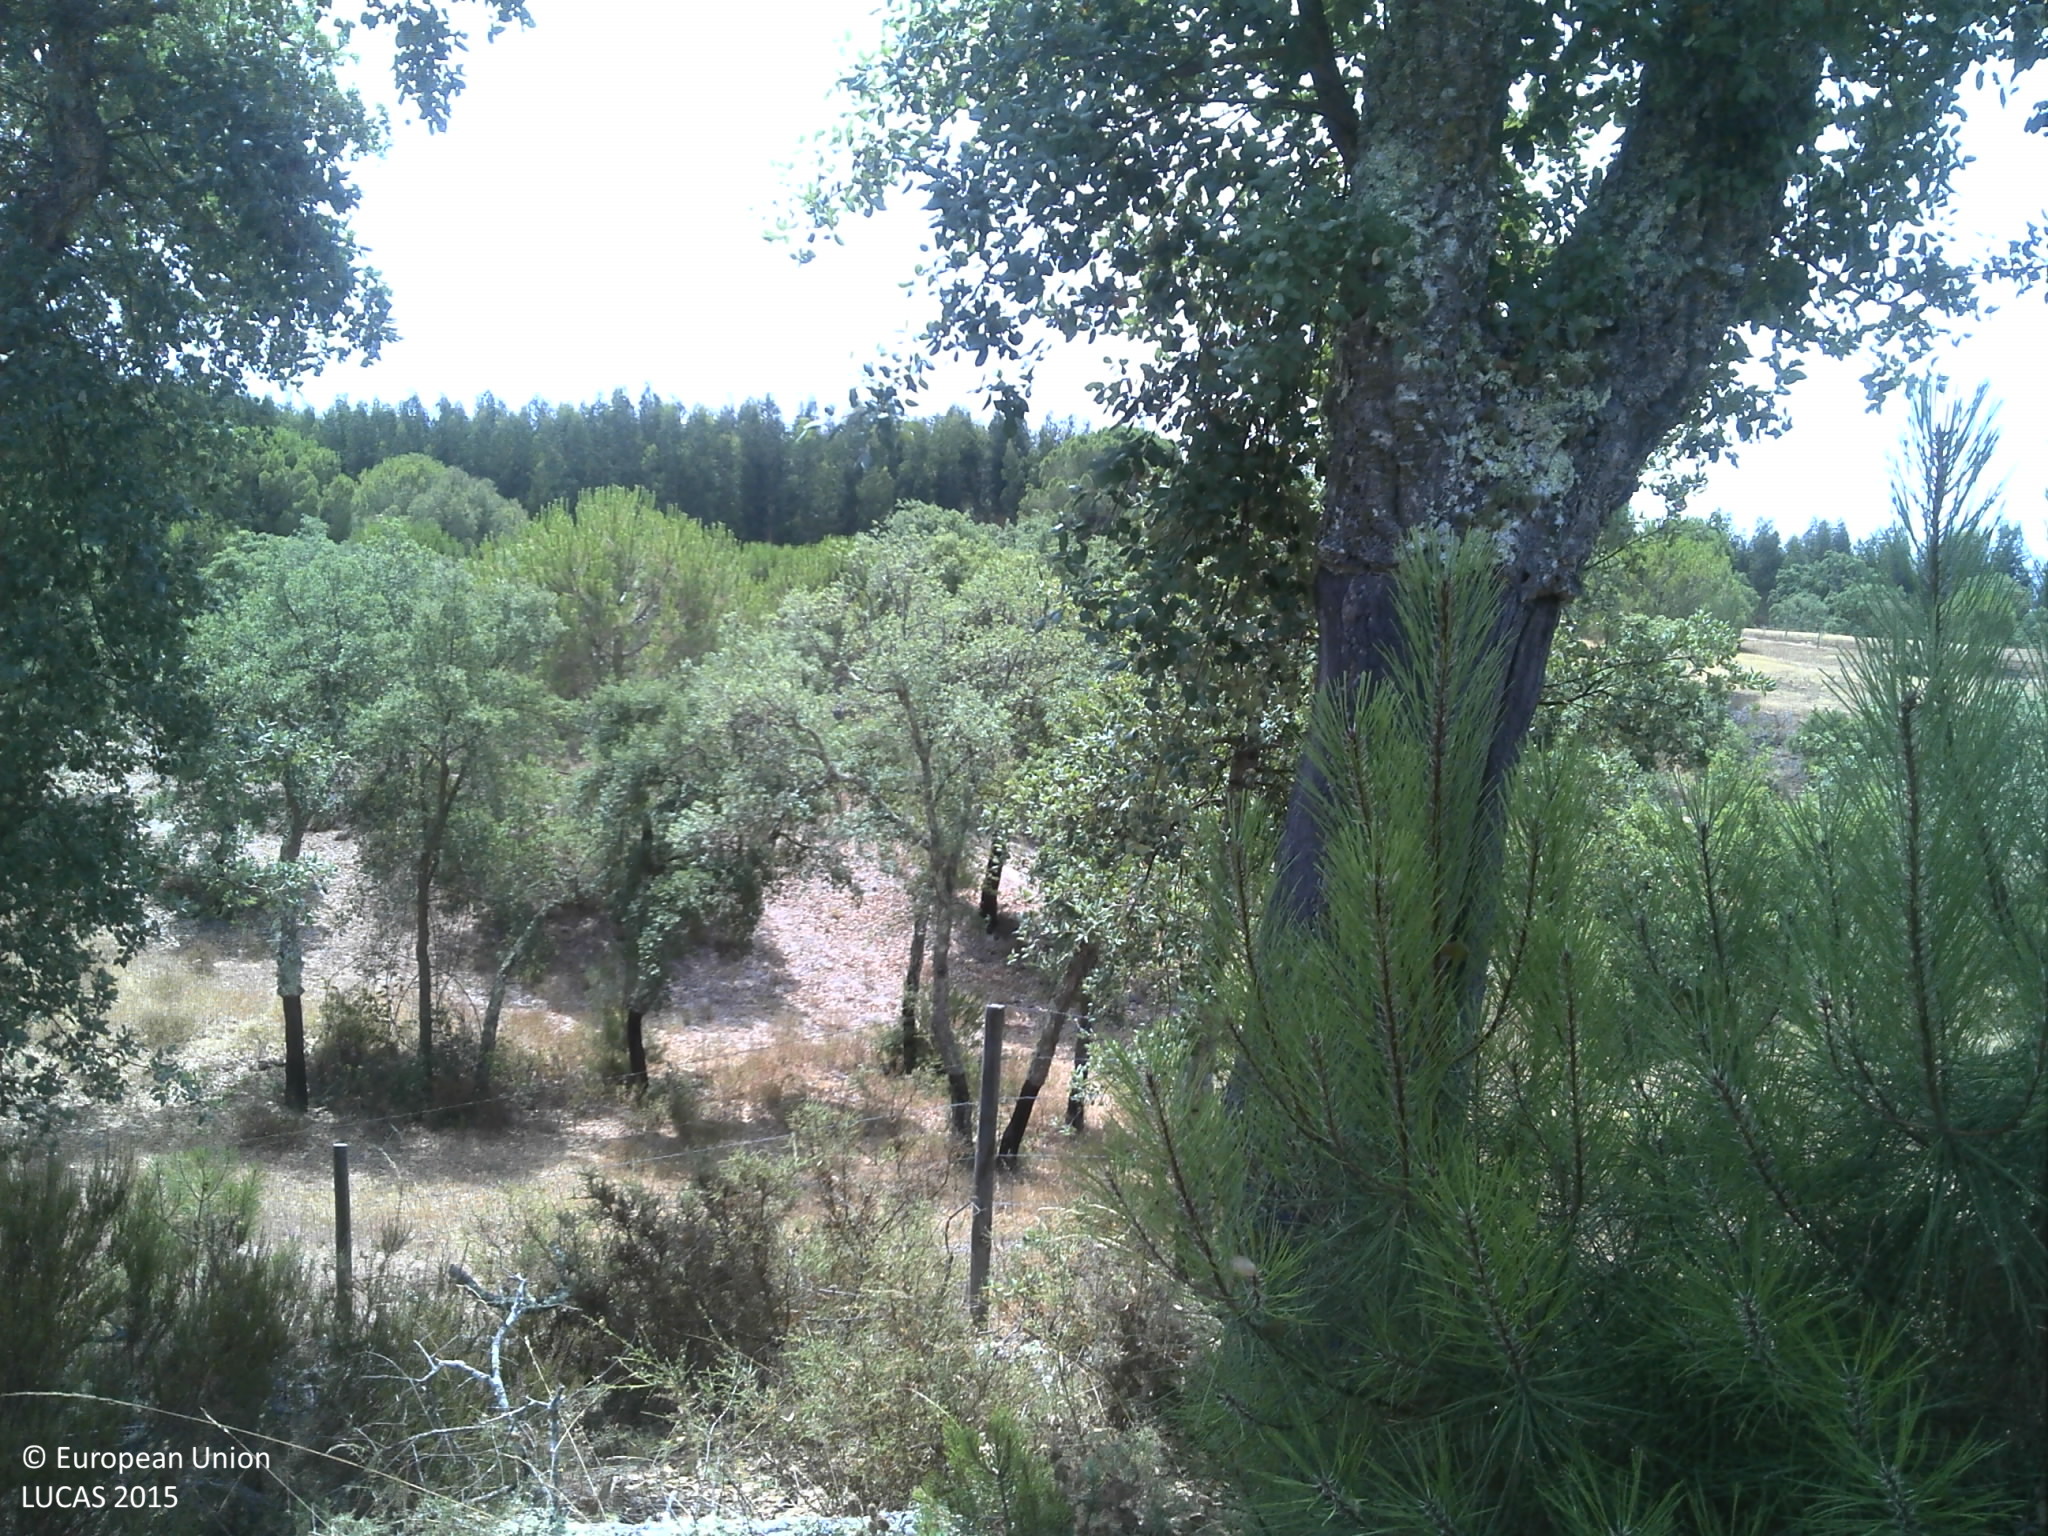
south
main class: Woodland
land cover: Broadleaved woodland
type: broadleaved evergreen forest
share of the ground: 25 - 50 %
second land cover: Grassland without tree/shrub cover
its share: 25 - 50 %
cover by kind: broadleaved forest trees 35 %, herbaceous plants 35 %, unconsolidated bare surface 30 %
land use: Forestry
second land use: Agriculture (excluding fallow land and kitchen gardens)
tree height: > 5 m
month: July
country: PT
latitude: 39.1518
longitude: -8.2376
